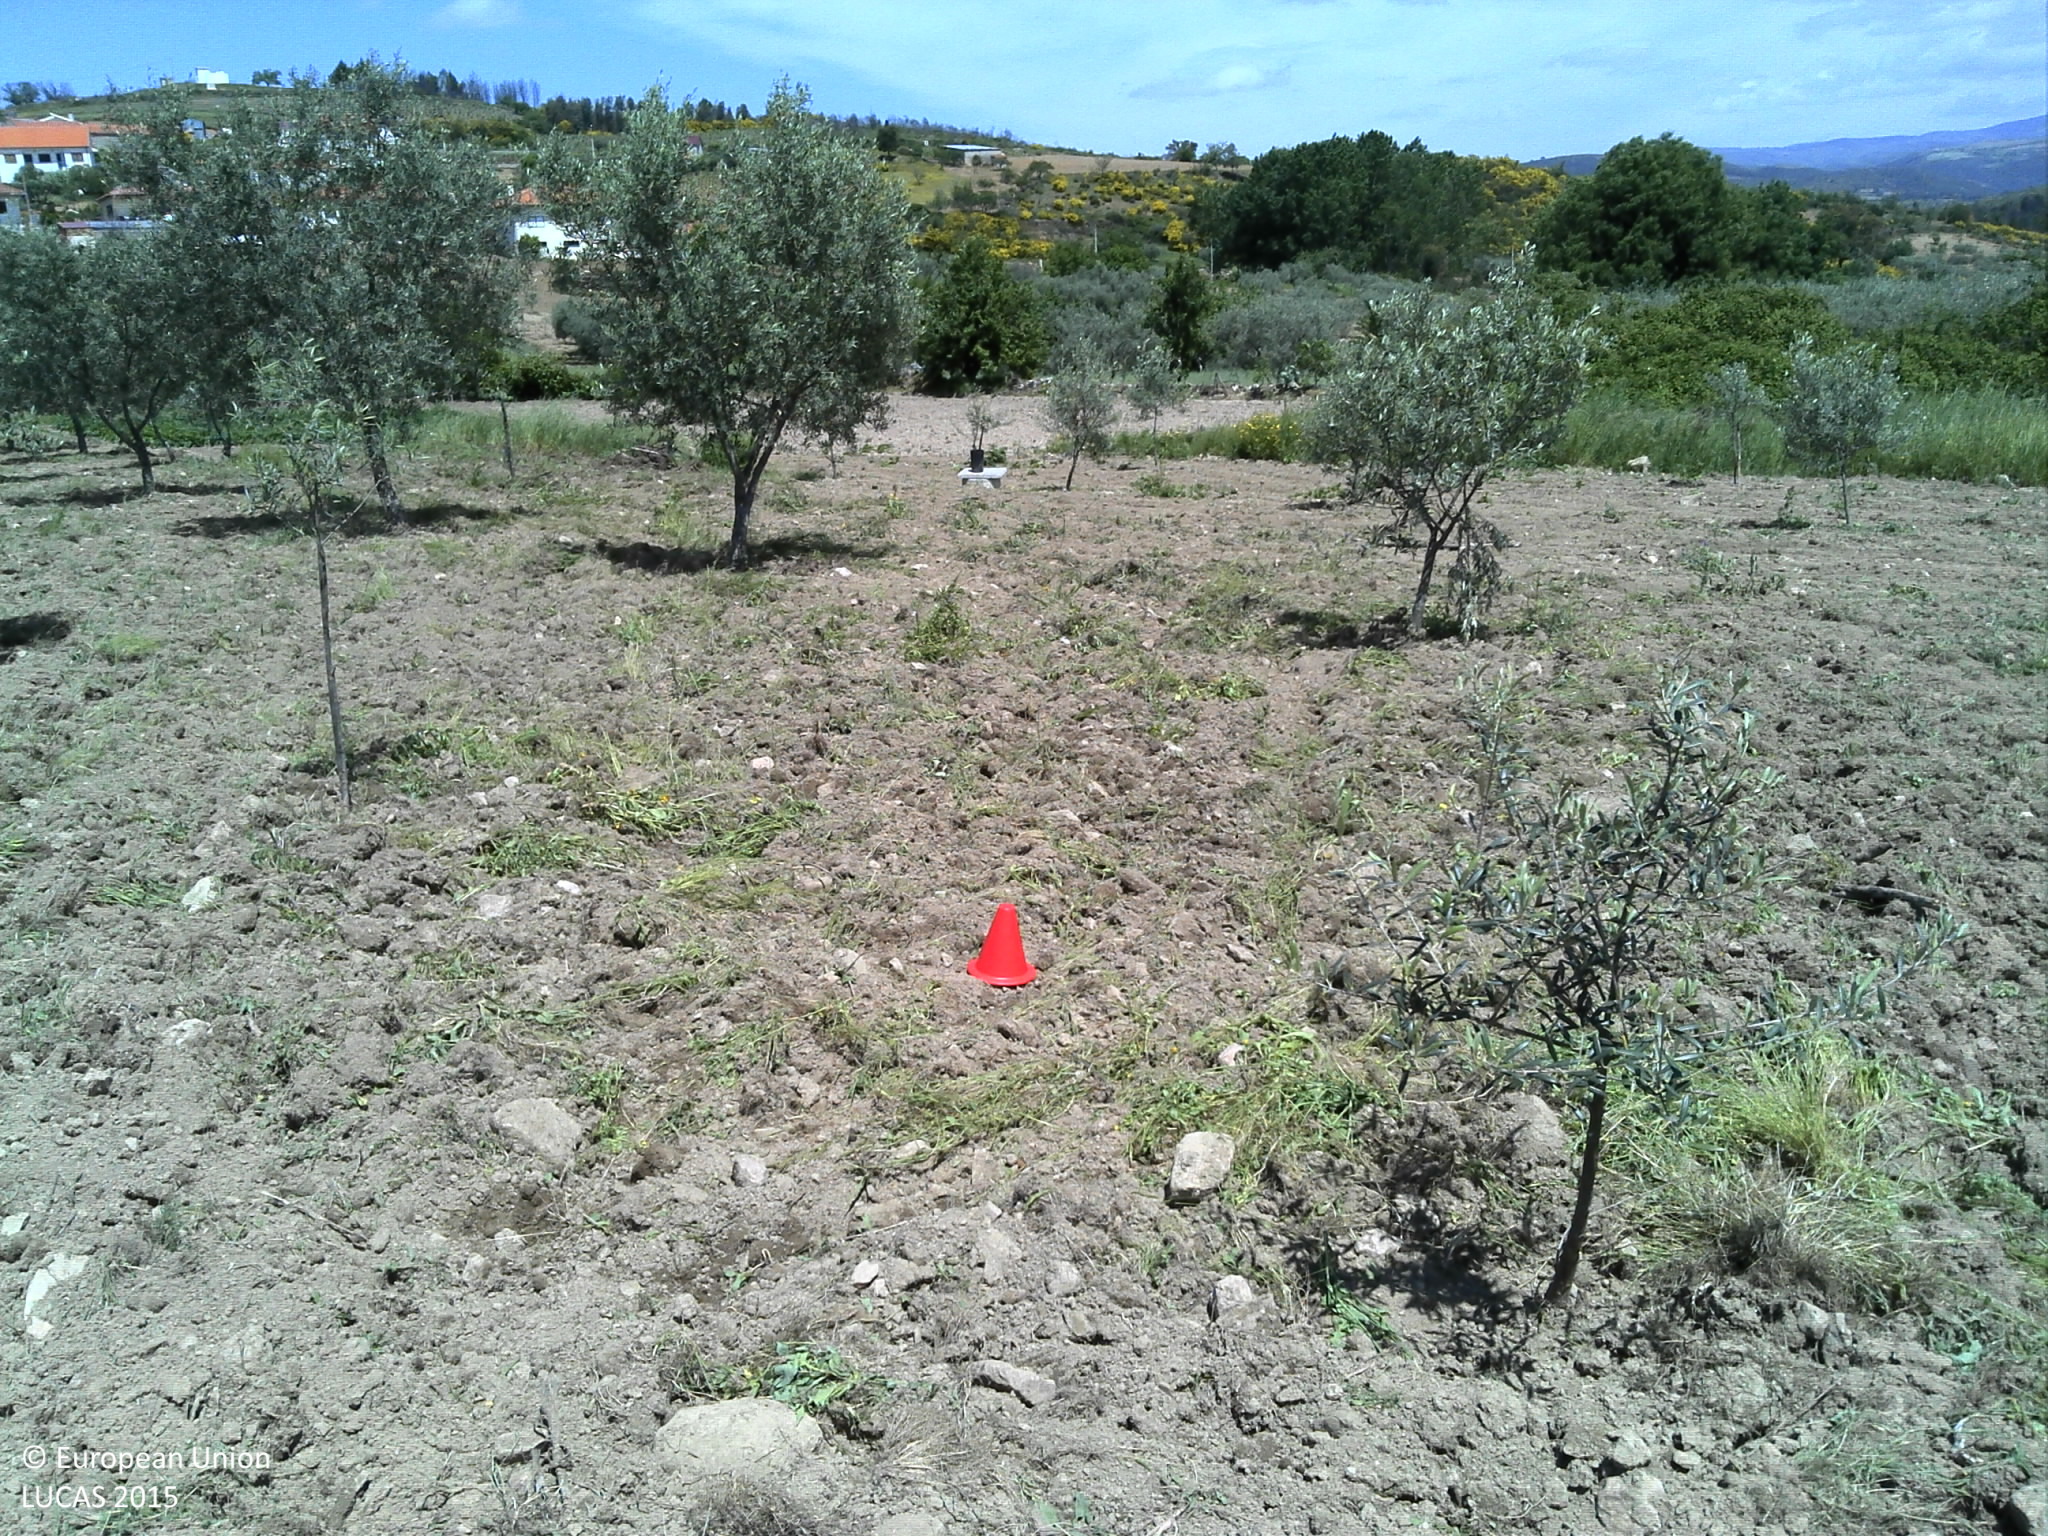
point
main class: Cropland
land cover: Olive groves
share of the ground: < 10 %
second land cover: Spontaneously vegetated surfaces
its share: < 10 %
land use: Agriculture (excluding fallow land and kitchen gardens)
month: May
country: PT
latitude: 41.7069
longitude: -7.0767
